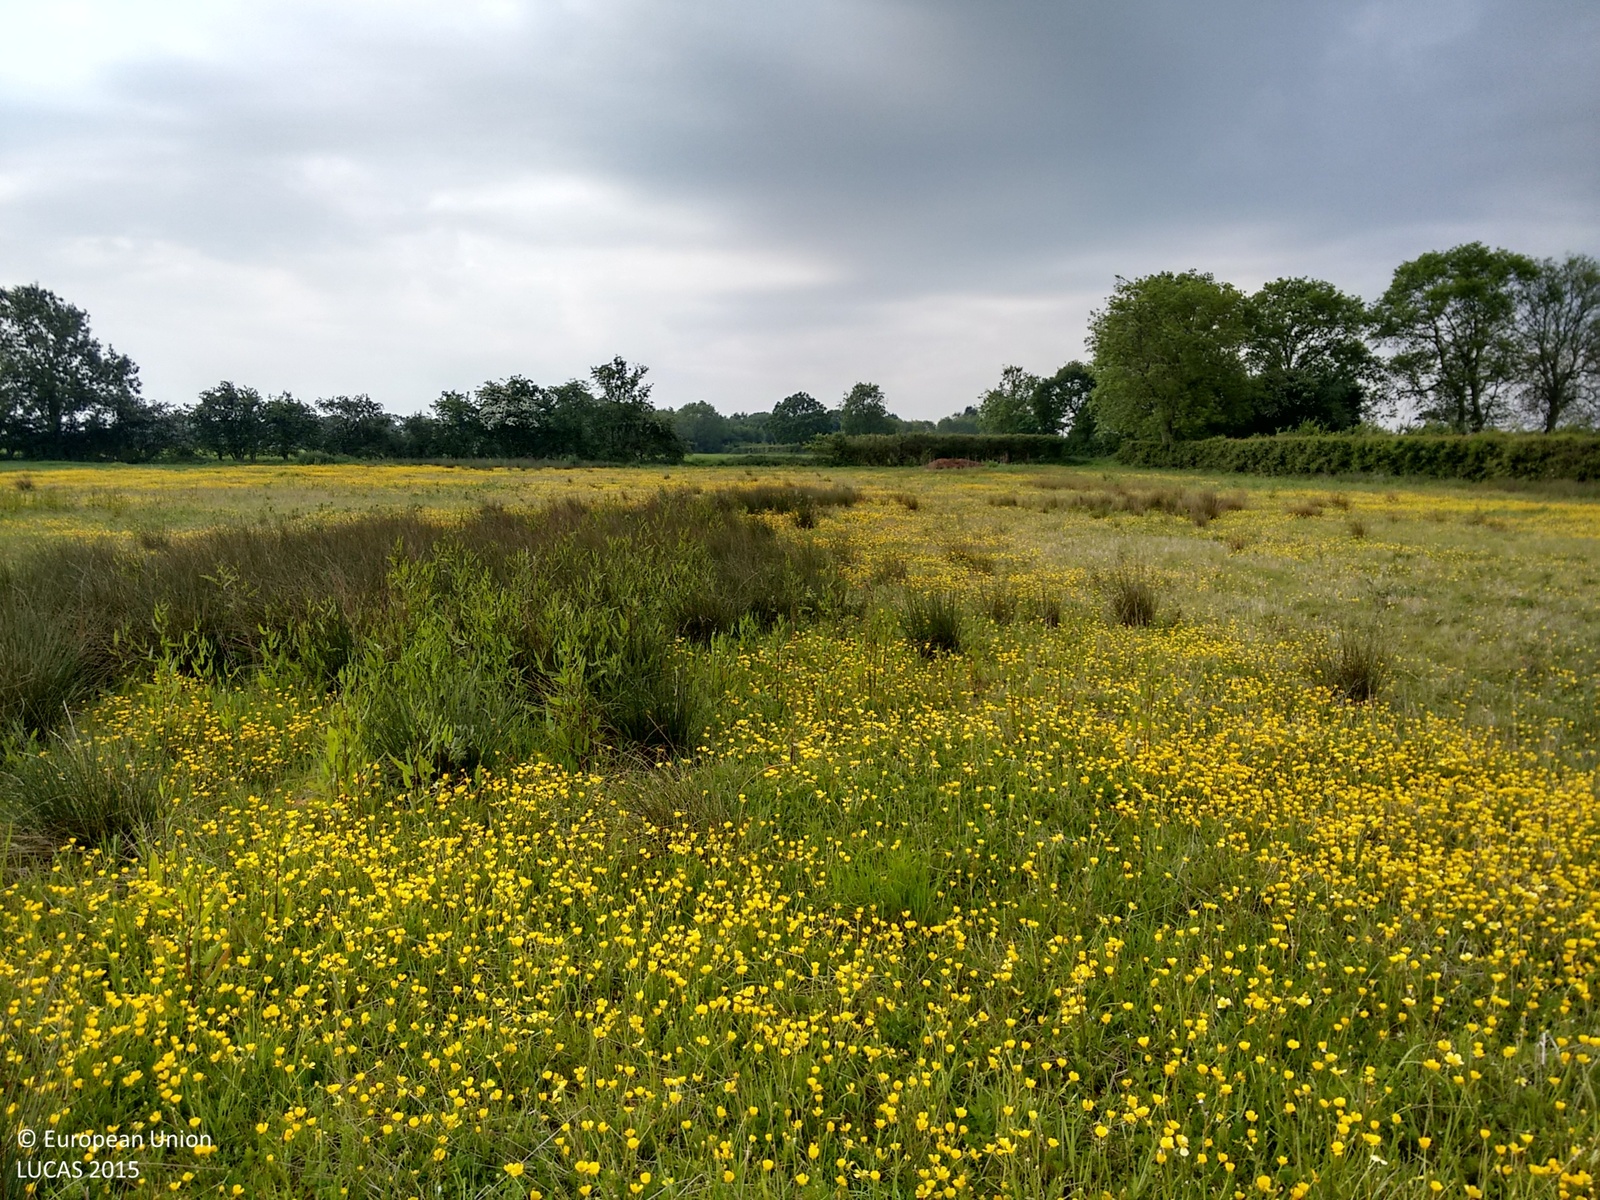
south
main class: Grassland
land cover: Spontaneously vegetated surfaces
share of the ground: > 75 %
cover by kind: herbaceous plants 95 %, shrubs 5 %
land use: Fallow land
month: June
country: GB
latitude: 54.0298
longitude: -1.1432
